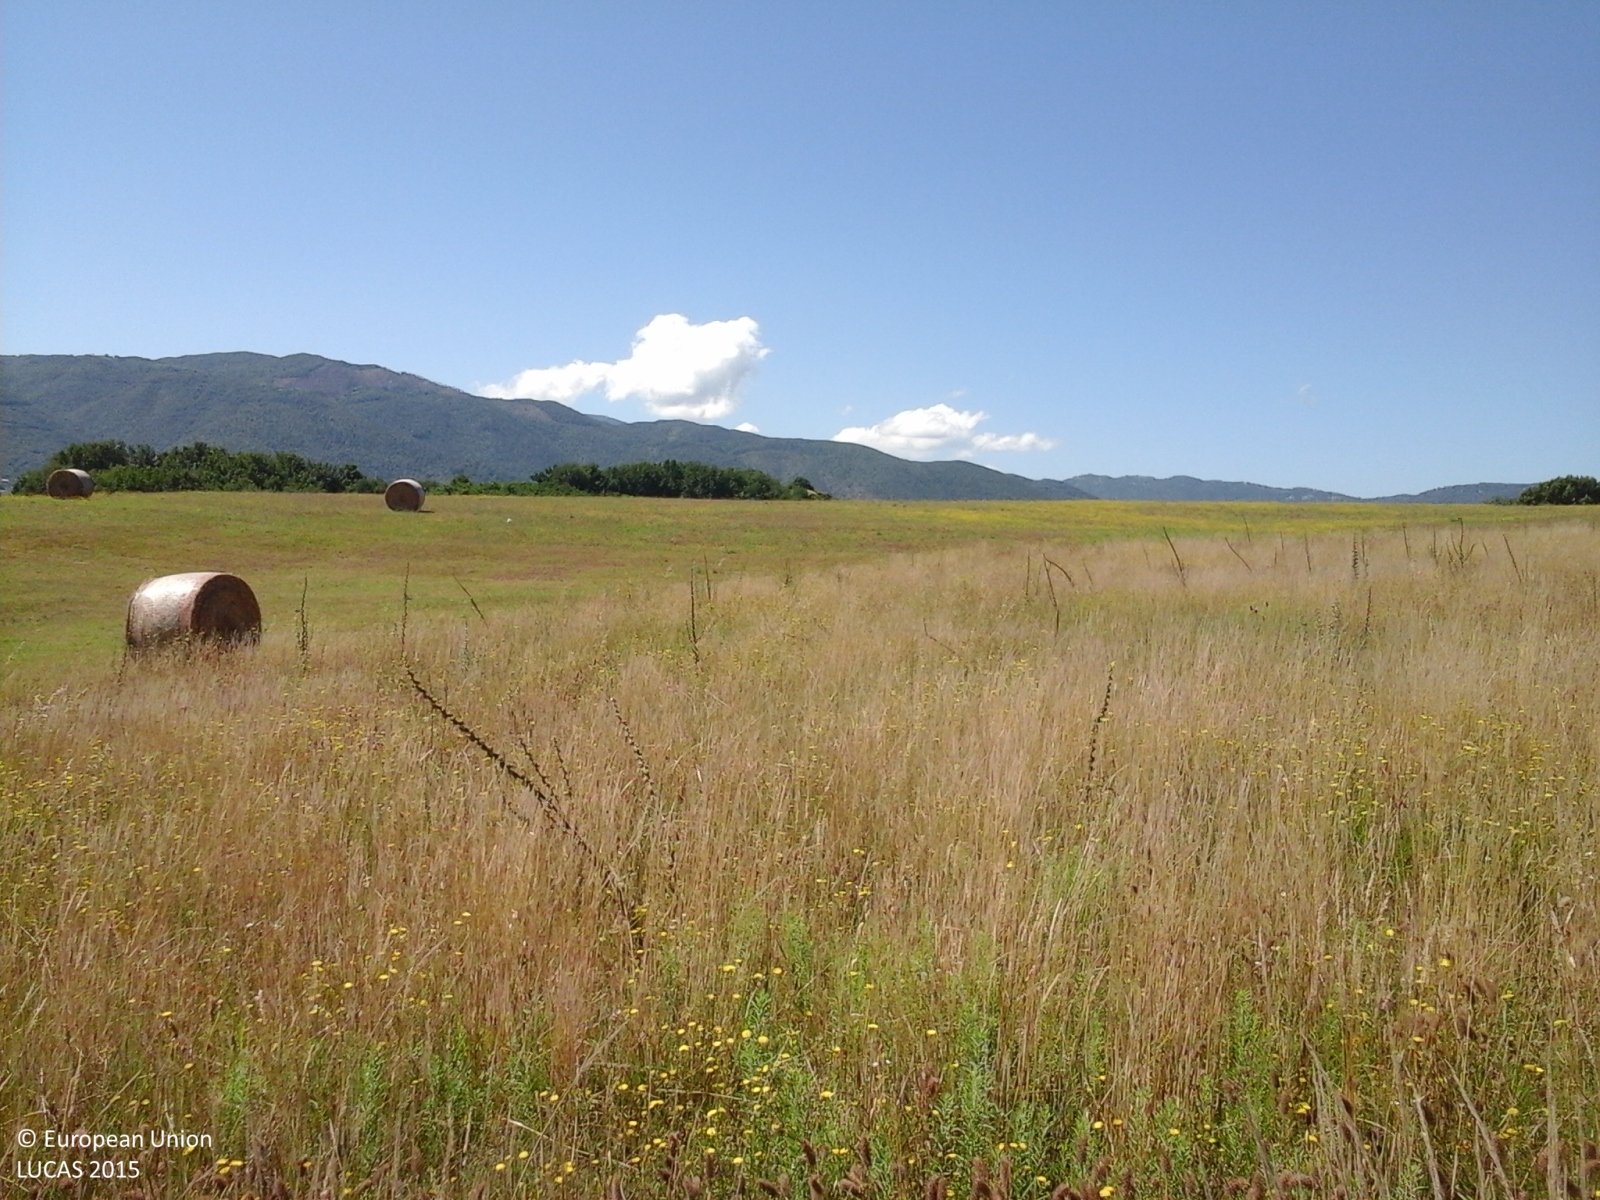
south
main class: Grassland
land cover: Grassland without tree/shrub cover
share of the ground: > 75 %
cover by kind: herbaceous plants 100 %
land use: Agriculture (excluding fallow land and kitchen gardens)
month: June
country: IT
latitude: 41.7033
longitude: 13.0768
